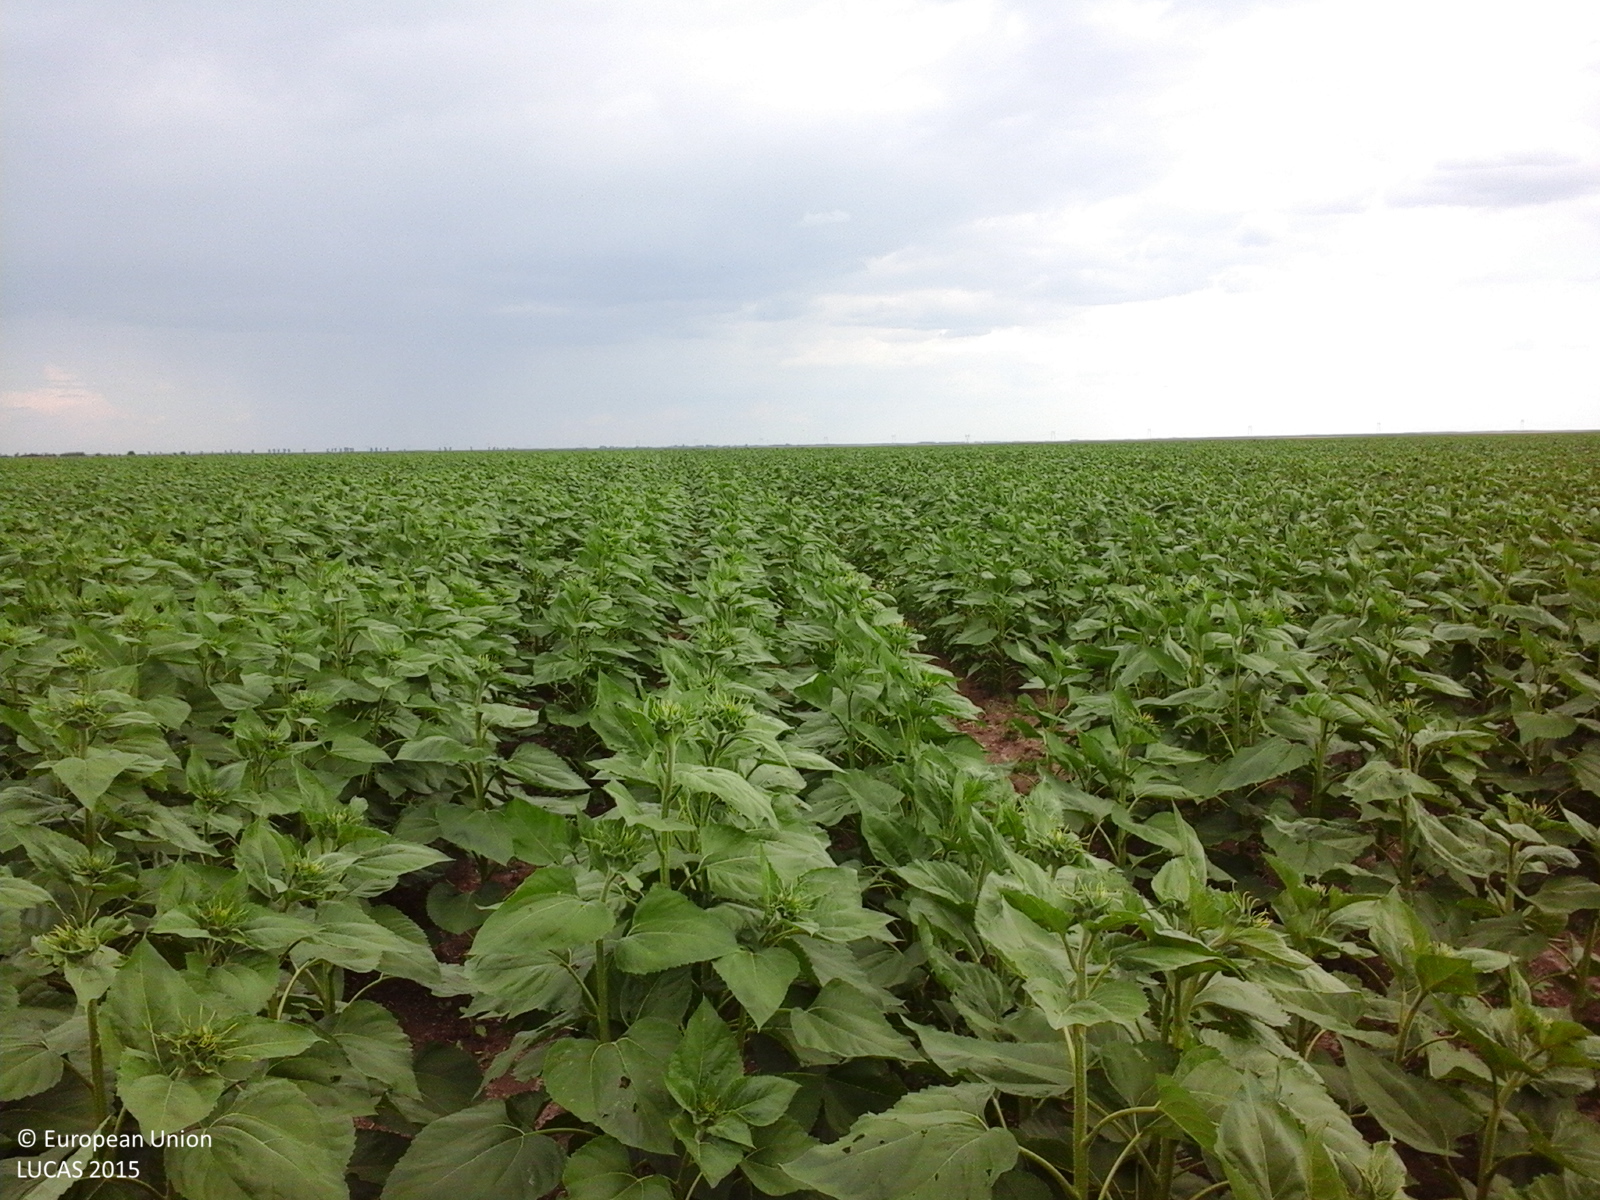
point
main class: Cropland
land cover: Sunflower
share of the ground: > 75 %
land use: Agriculture (excluding fallow land and kitchen gardens)
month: July
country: RO
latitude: 44.3388
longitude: 24.8388
